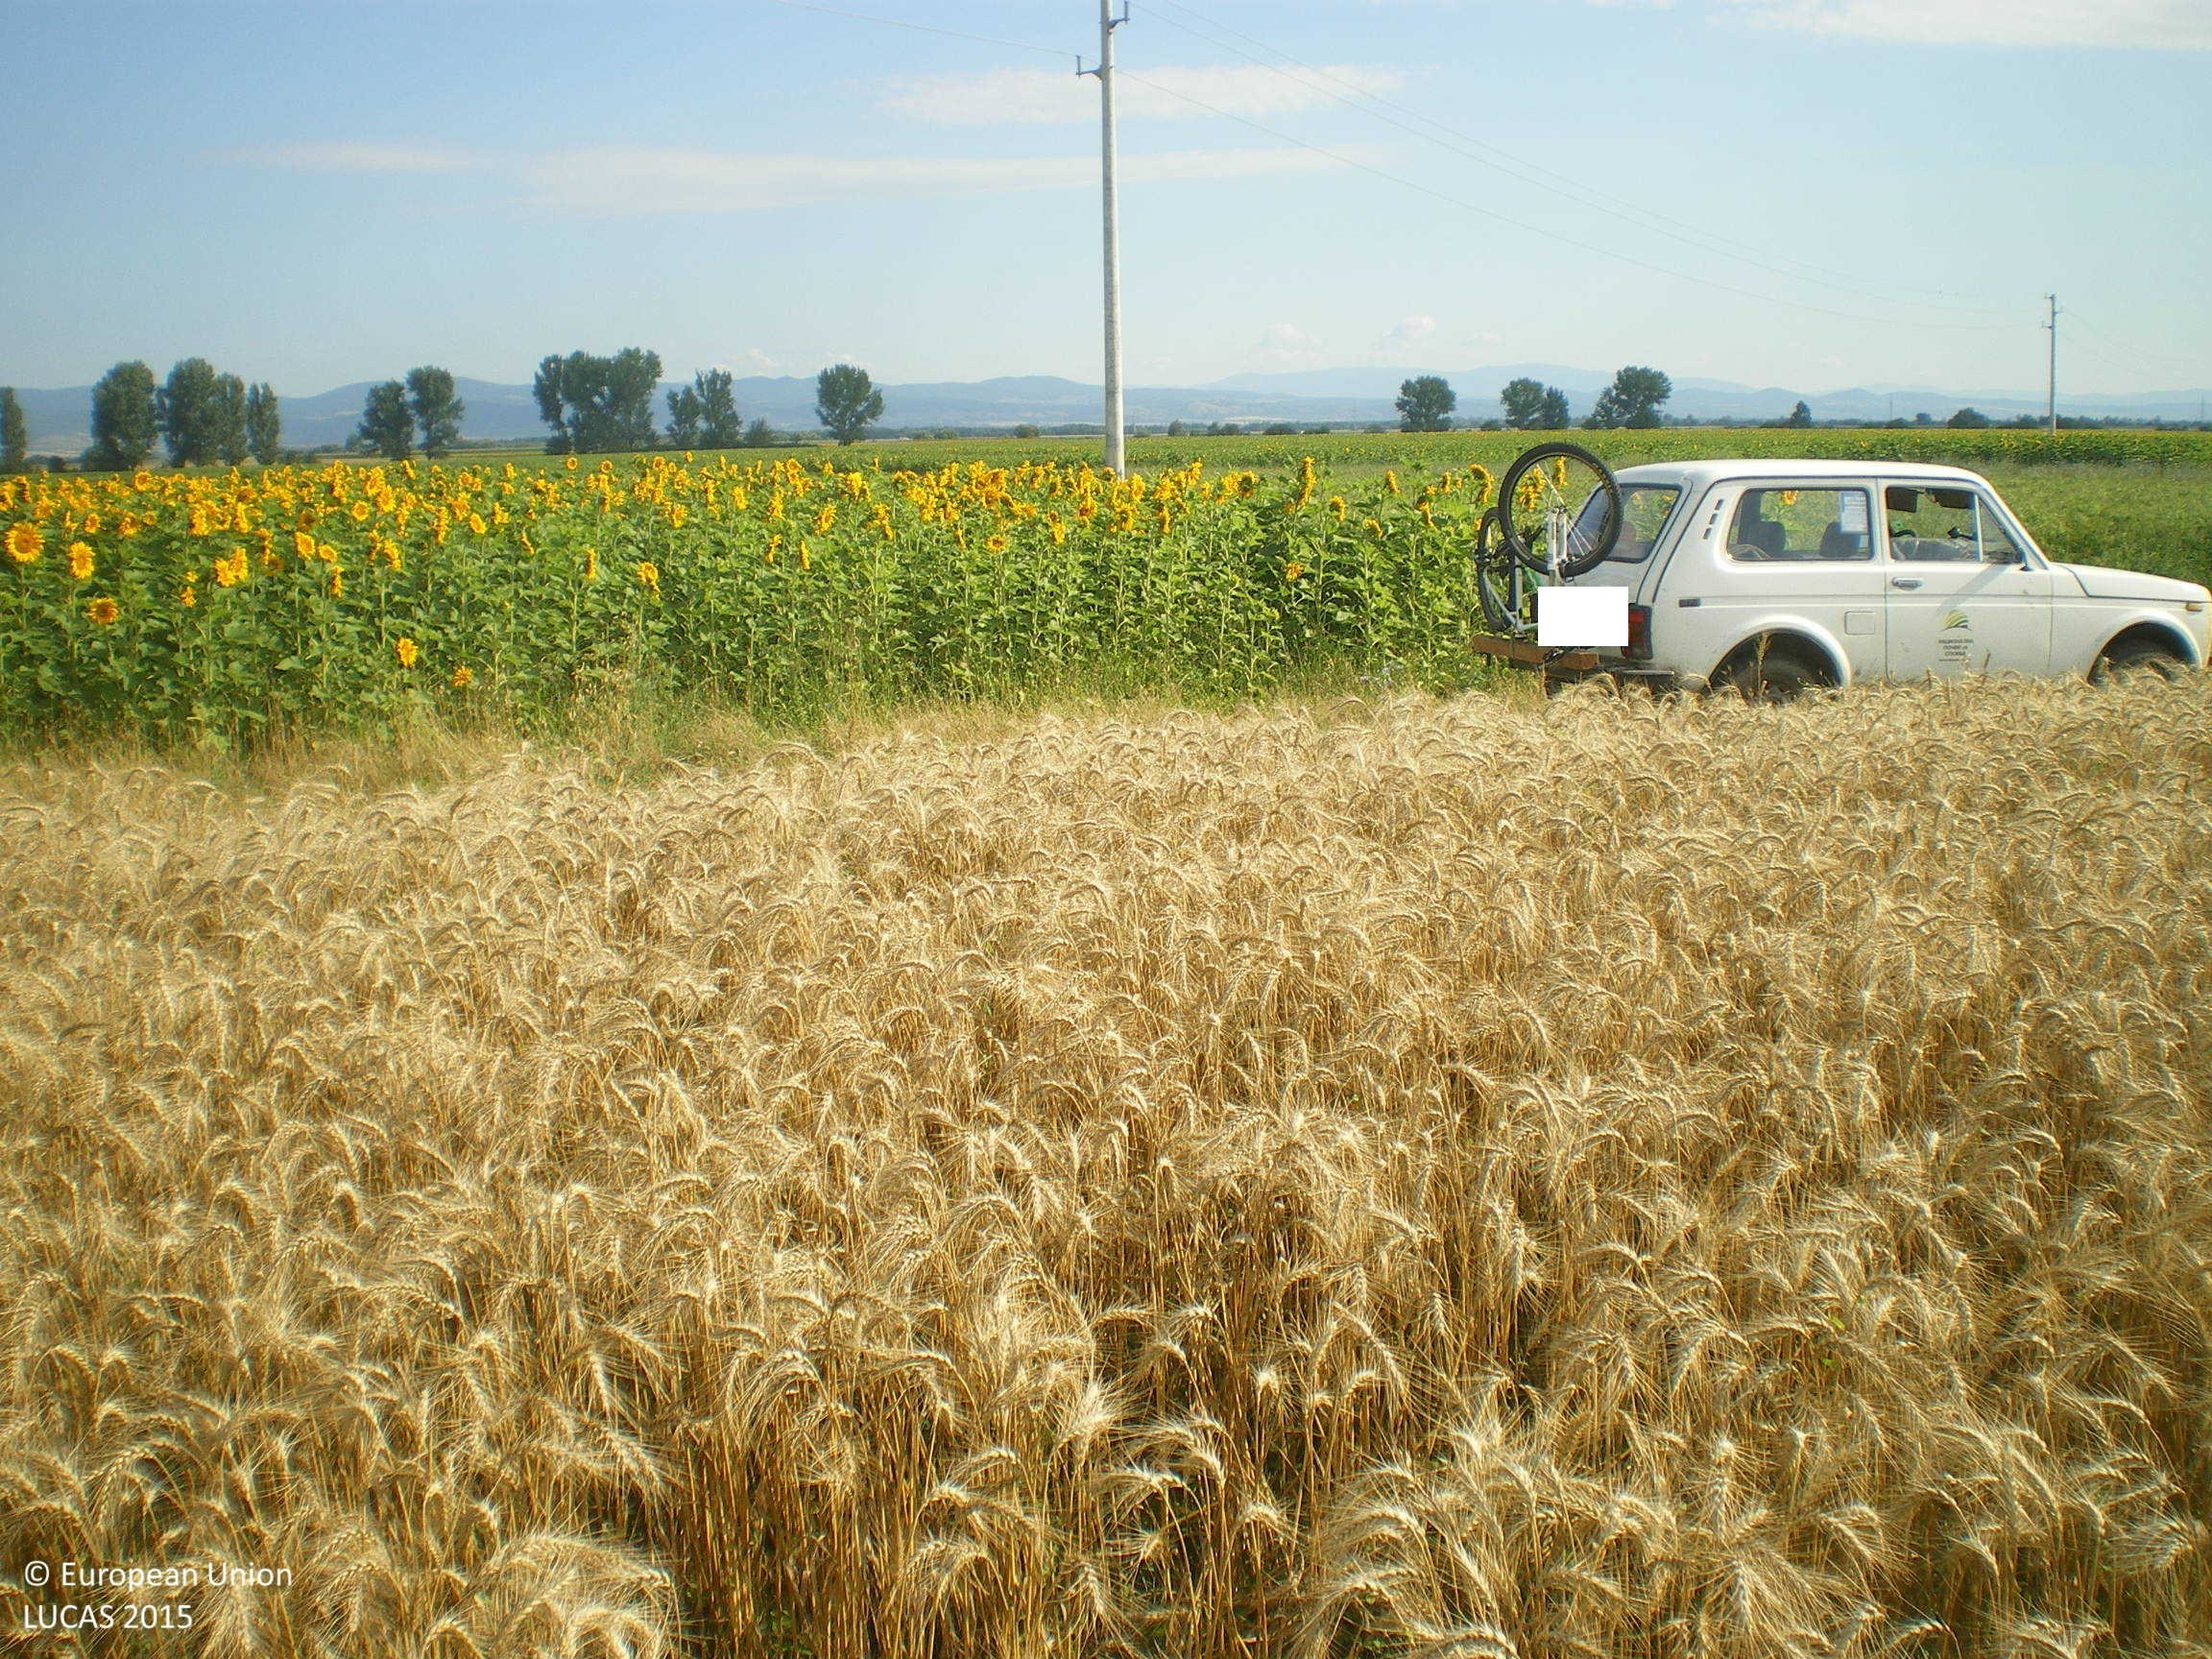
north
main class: Cropland
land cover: Barley
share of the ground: > 75 %
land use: Agriculture (excluding fallow land and kitchen gardens)
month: July
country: BG
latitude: 42.3702
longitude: 25.8502
